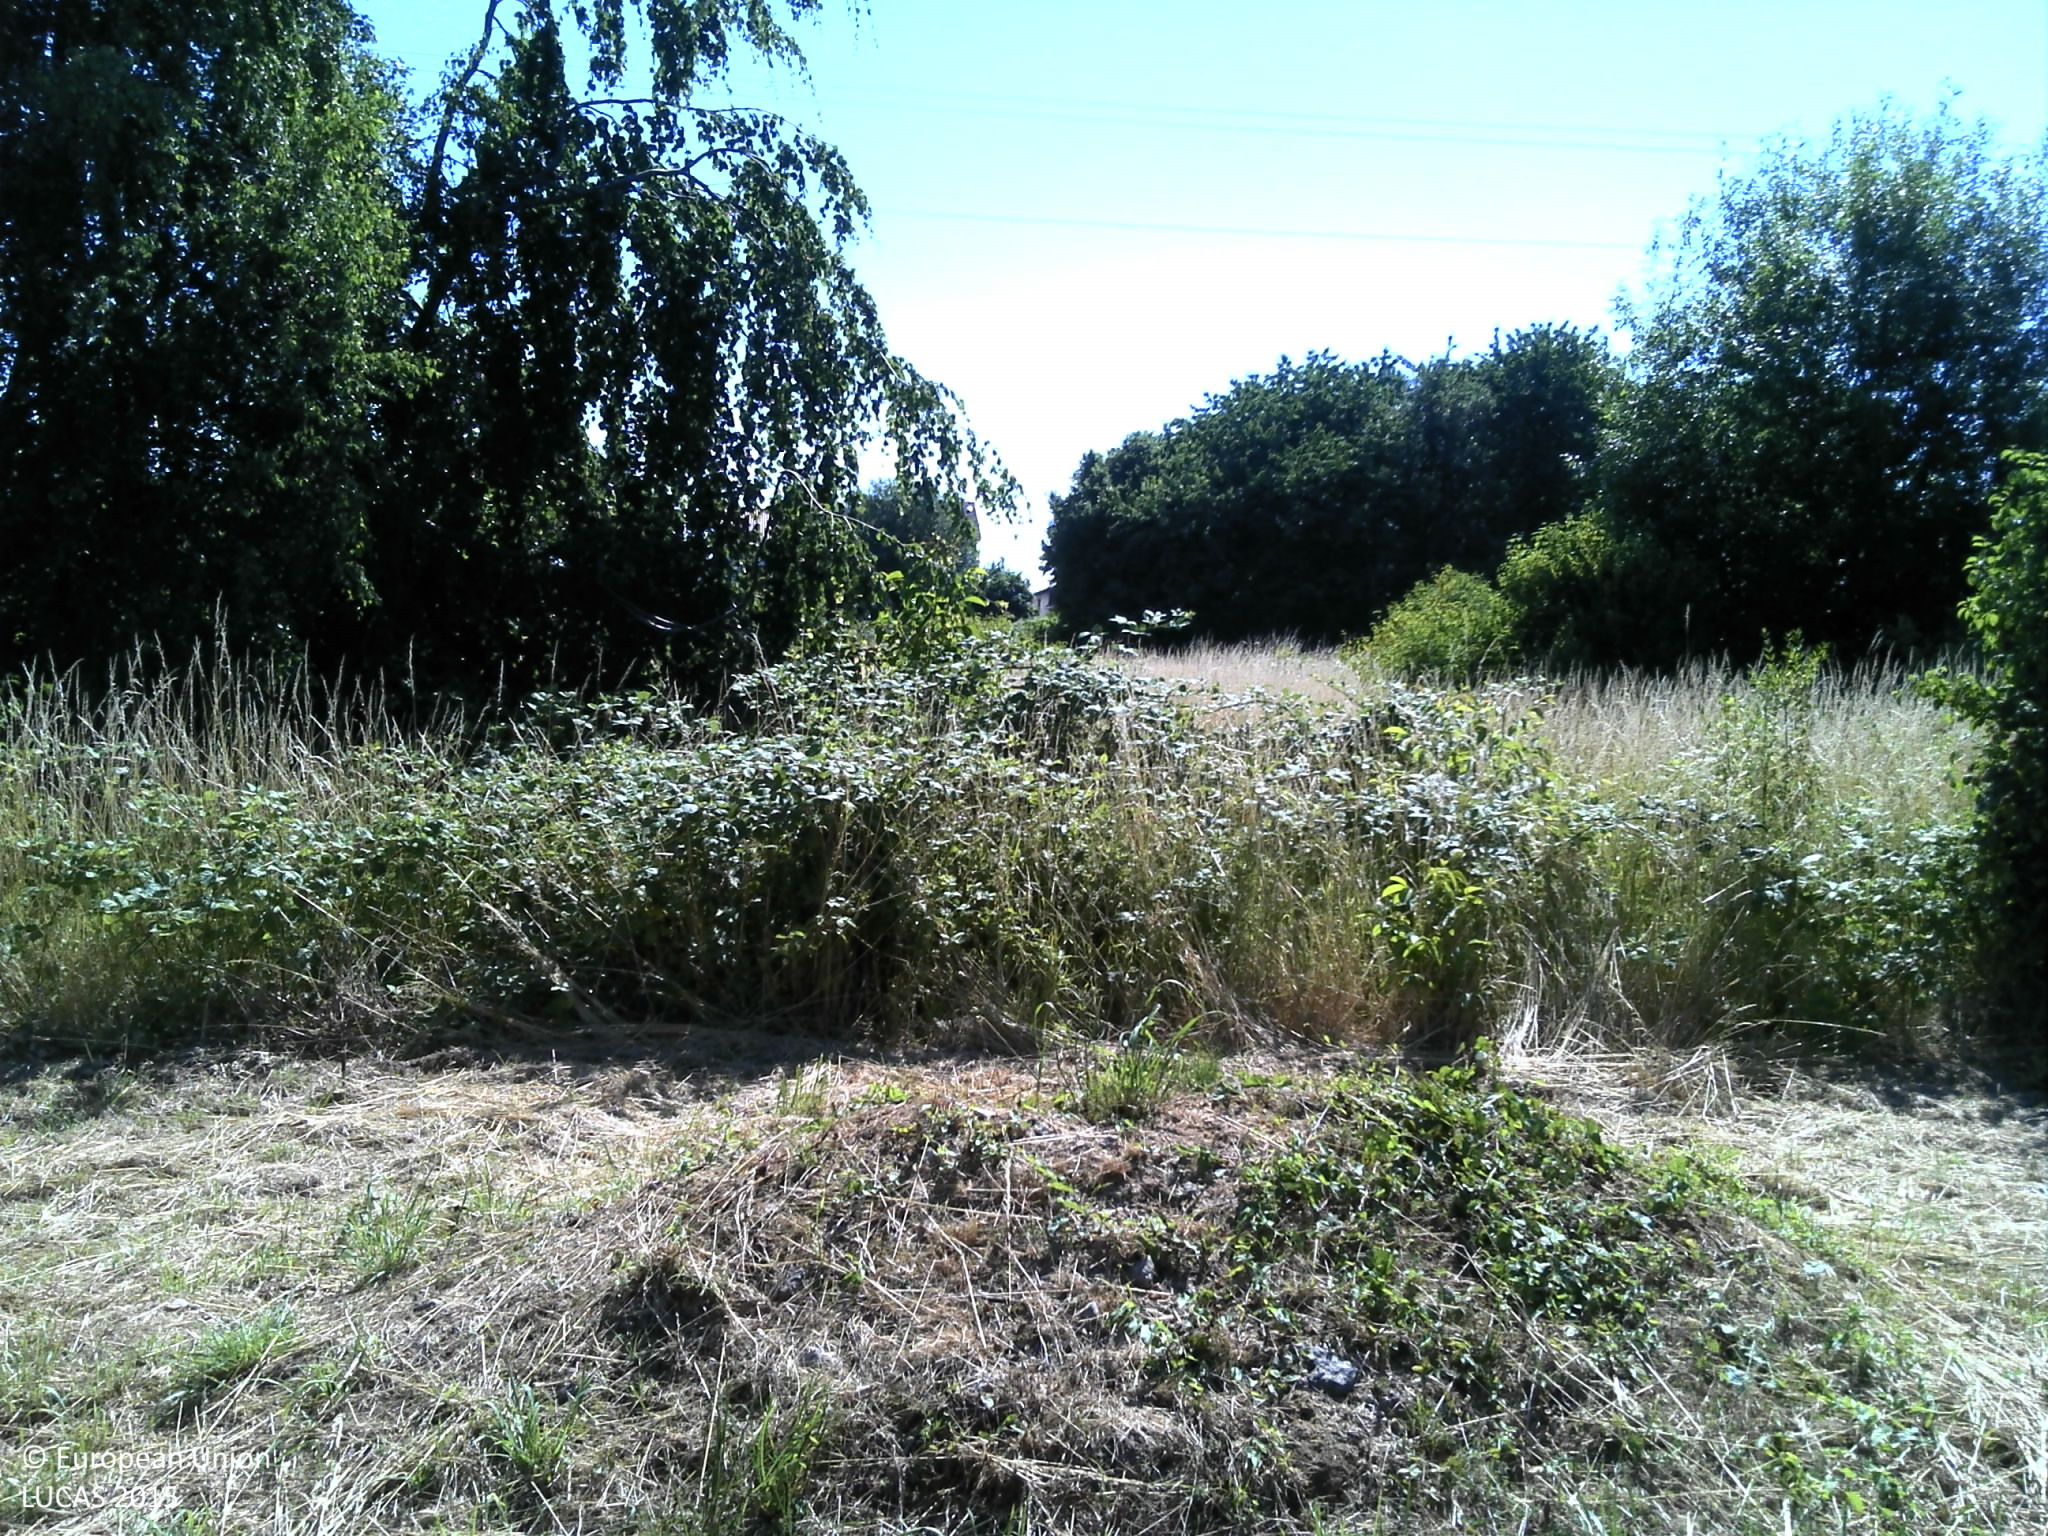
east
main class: Grassland
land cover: Spontaneously vegetated surfaces
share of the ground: 50 - 75 %
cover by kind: unconsolidated bare surface 50 %, herbaceous plants 30 %, lichens and mosses 20 %
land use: Community services
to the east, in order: Spontaneously vegetated surfaces; Grassland without tree/shrub cover; Grassland with sparse tree/shrub cover; Barley; Broadleaved woodland; Shrubland without tree cover; Broadleaved woodland; Fences; Artificial constructions in urban areas
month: June
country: FR
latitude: 49.3265
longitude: 6.1332
